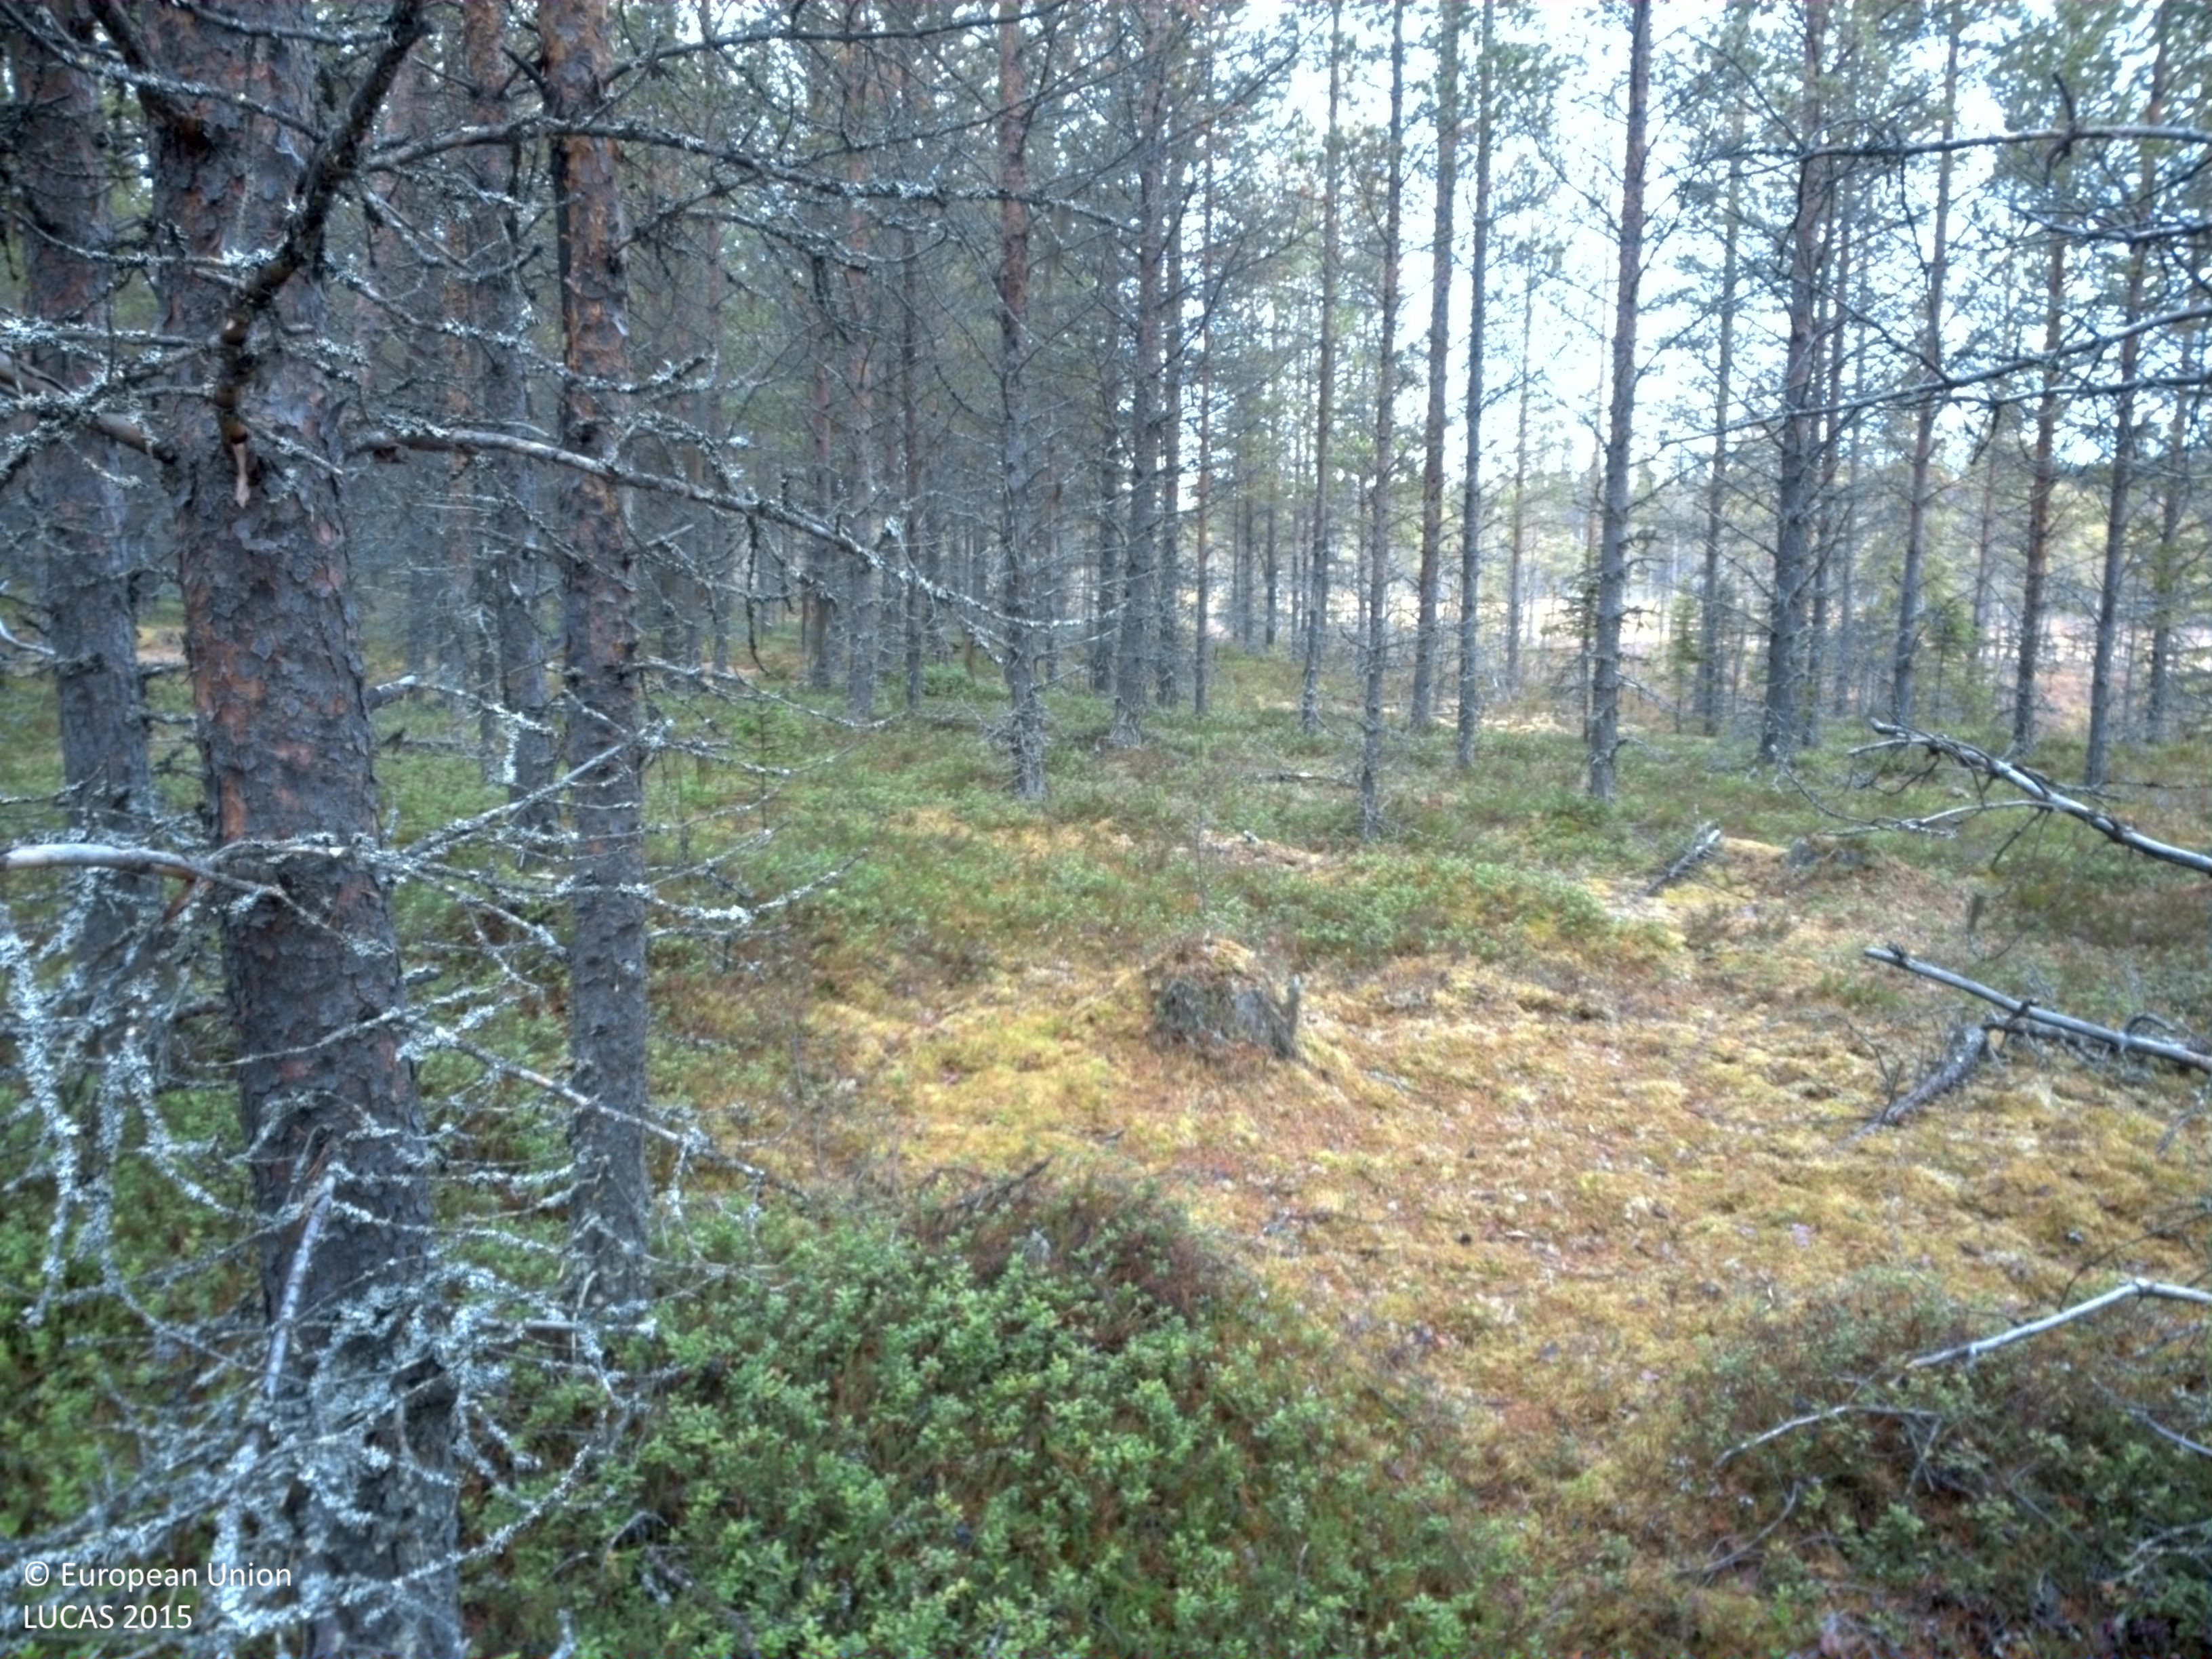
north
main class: Woodland
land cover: Pine dominated coniferous woodland
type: boreal forest
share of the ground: 25 - 50 %
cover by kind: coniferous forest trees 40 %, shrubs 40 %, lichens and mosses 20 %
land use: Forestry
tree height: > 5 m
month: October
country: SE
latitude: 64.6670
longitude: 16.8577
